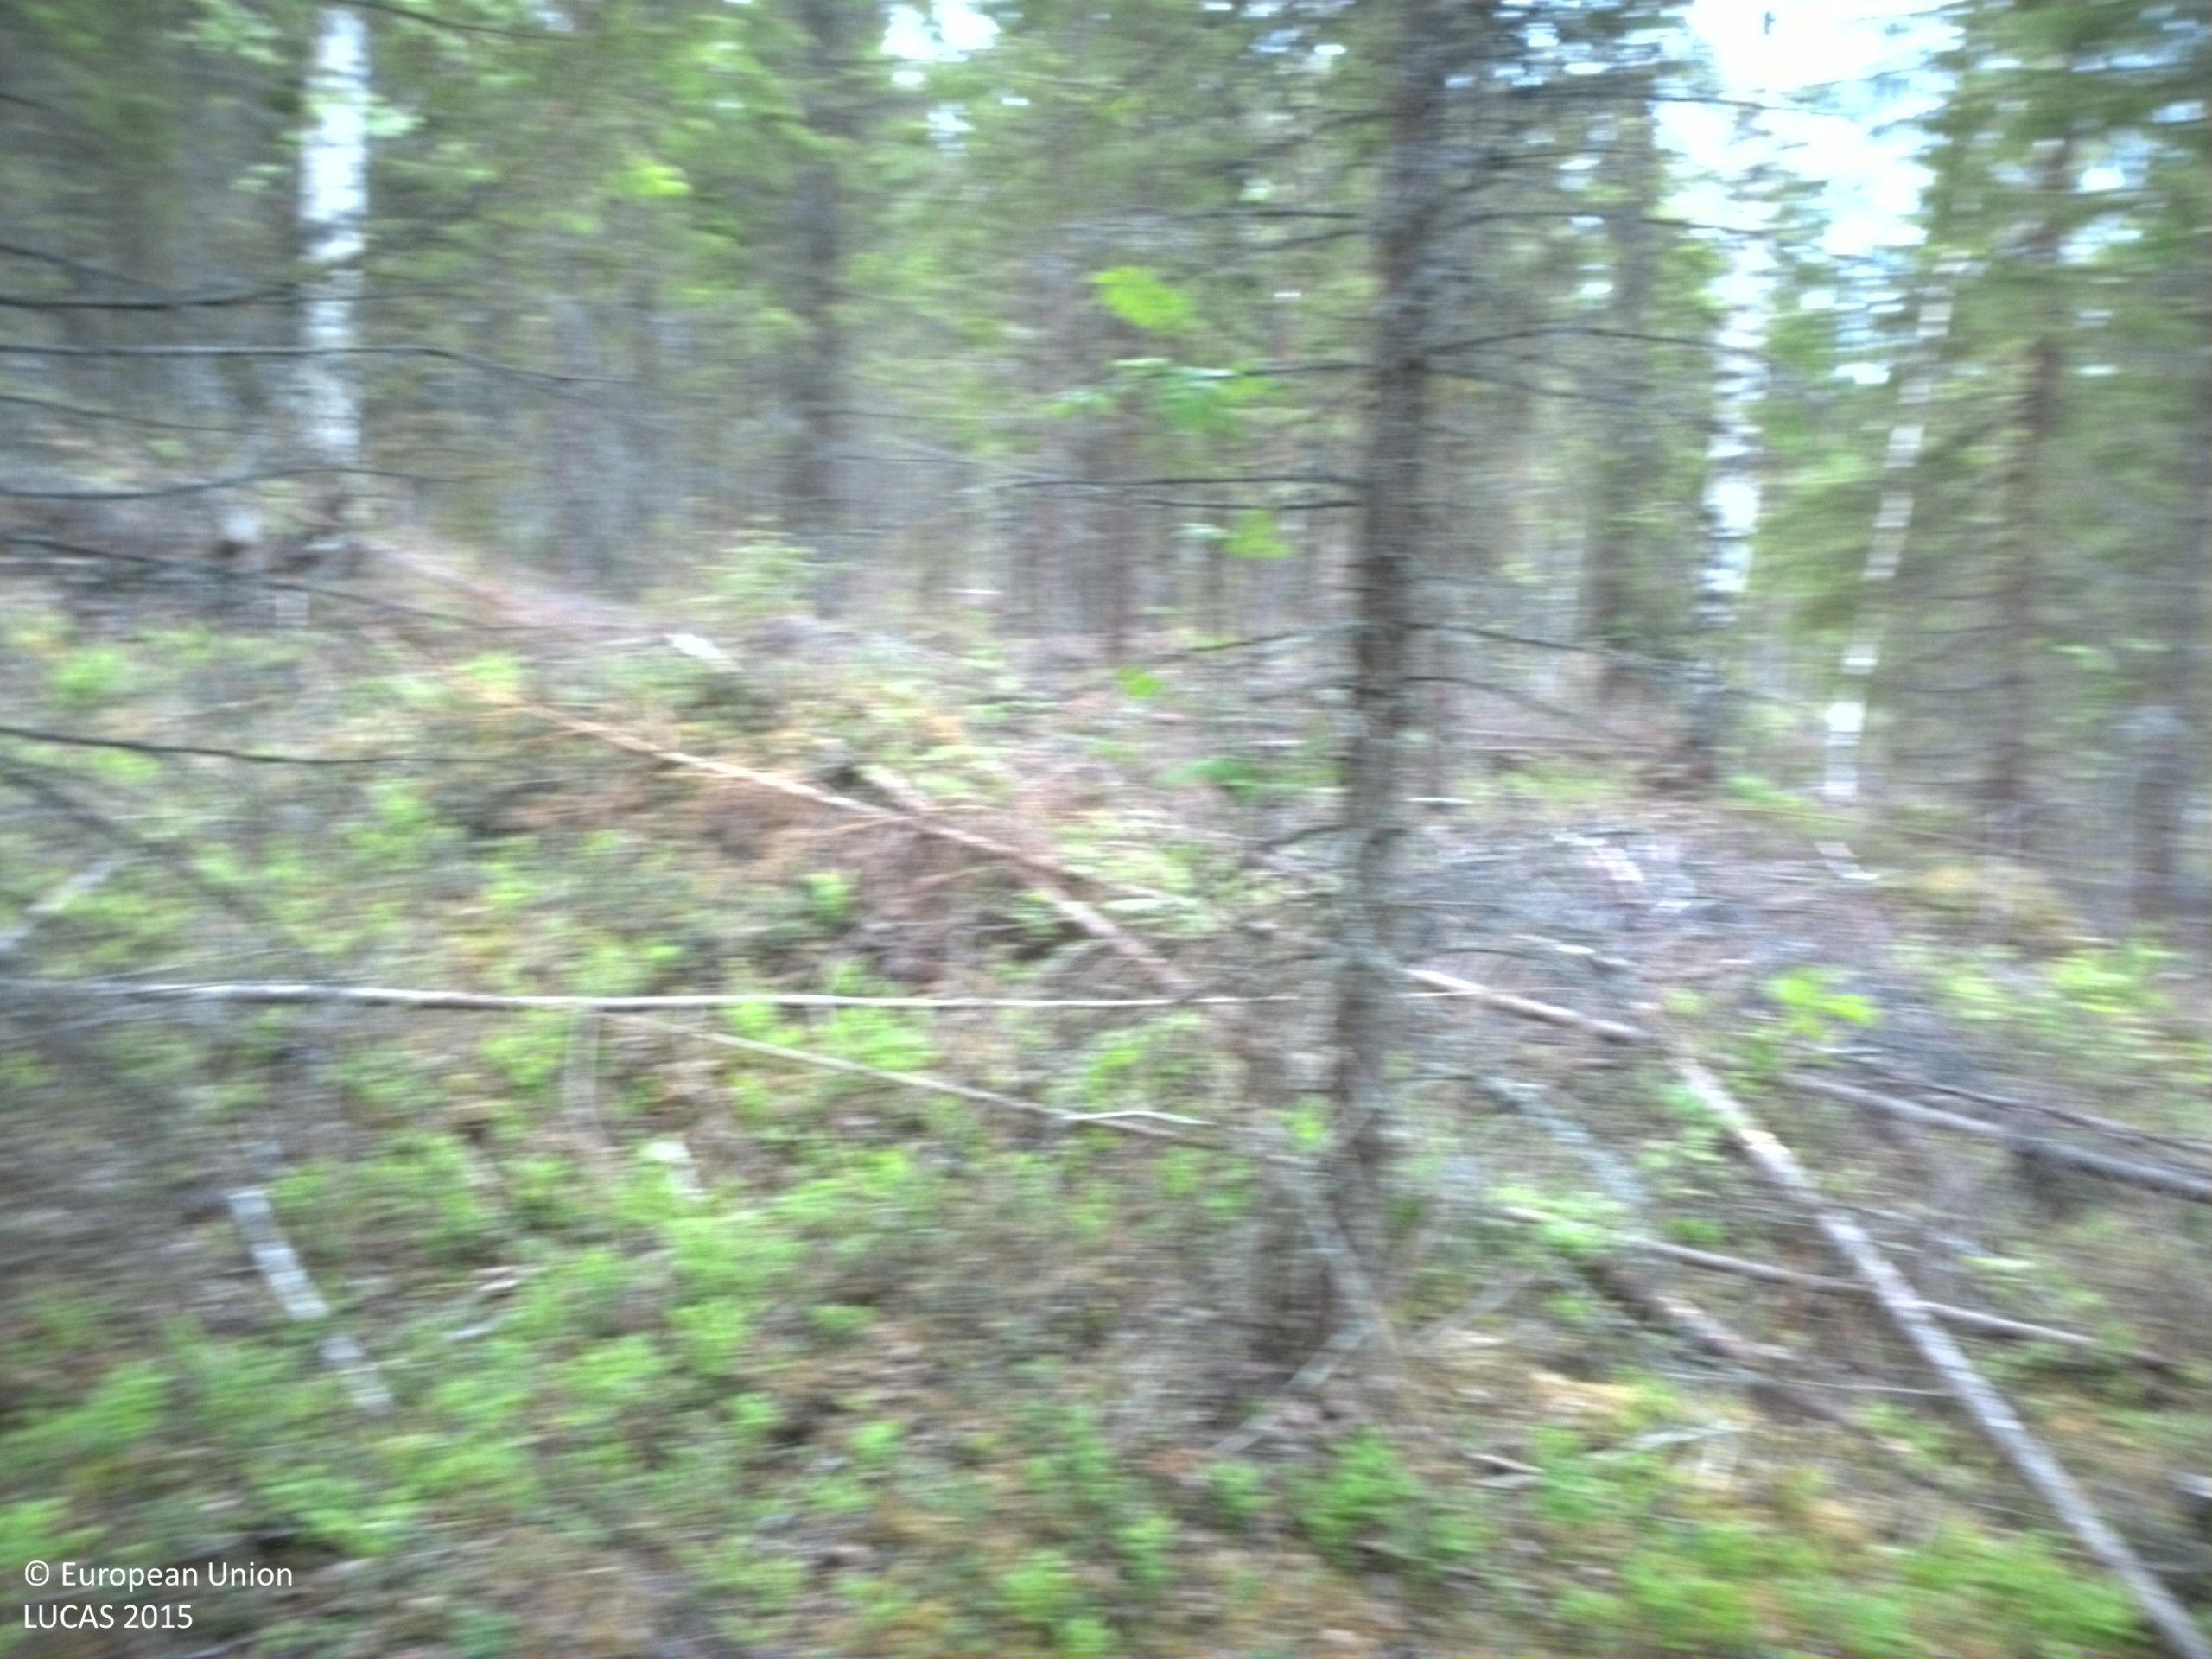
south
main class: Woodland
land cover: Spruce dominated coniferous woodland
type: boreal forest
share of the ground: > 75 %
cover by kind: coniferous forest trees 70 %, shrubs 15 %, broadleaved forest trees 5 %
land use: Forestry
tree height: > 5 m
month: June
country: SE
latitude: 63.1508
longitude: 17.8557
